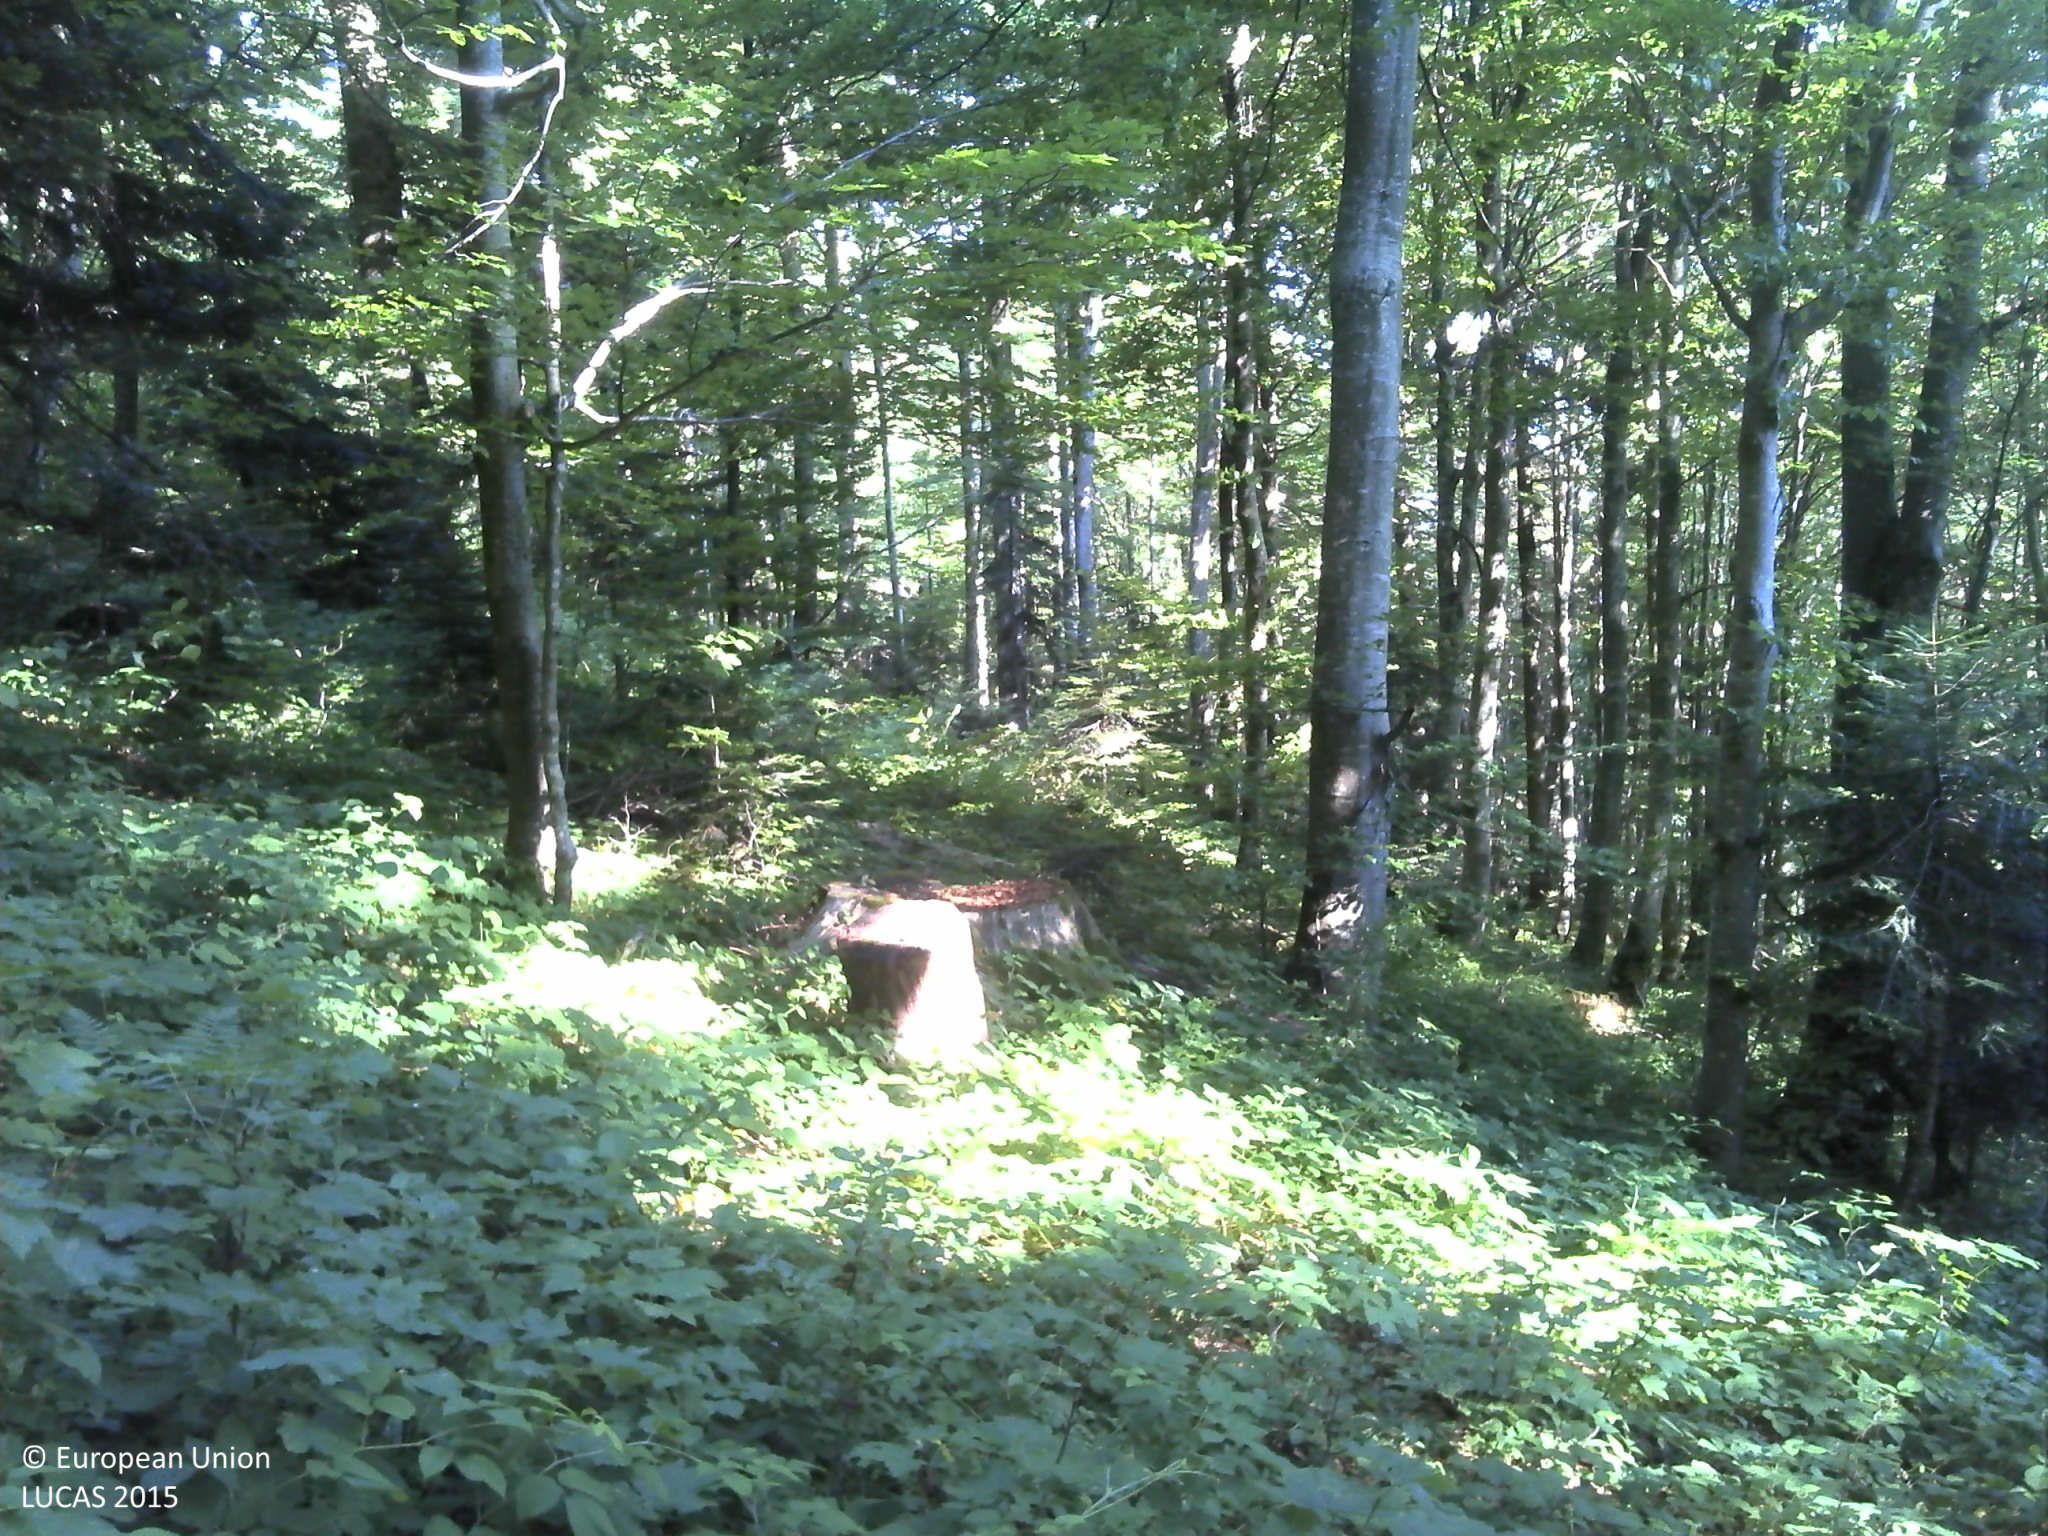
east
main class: Woodland
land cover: Broadleaved woodland
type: mountainous beech forest
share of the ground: > 75 %
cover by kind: broadleaved forest trees 90 %, shrubs 10 %
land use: Forestry
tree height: > 5 m
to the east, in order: Broadleaved woodland; Tracks; Broadleaved woodland; Other mixed woodland
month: July
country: HR
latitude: 45.0865
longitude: 15.2165
